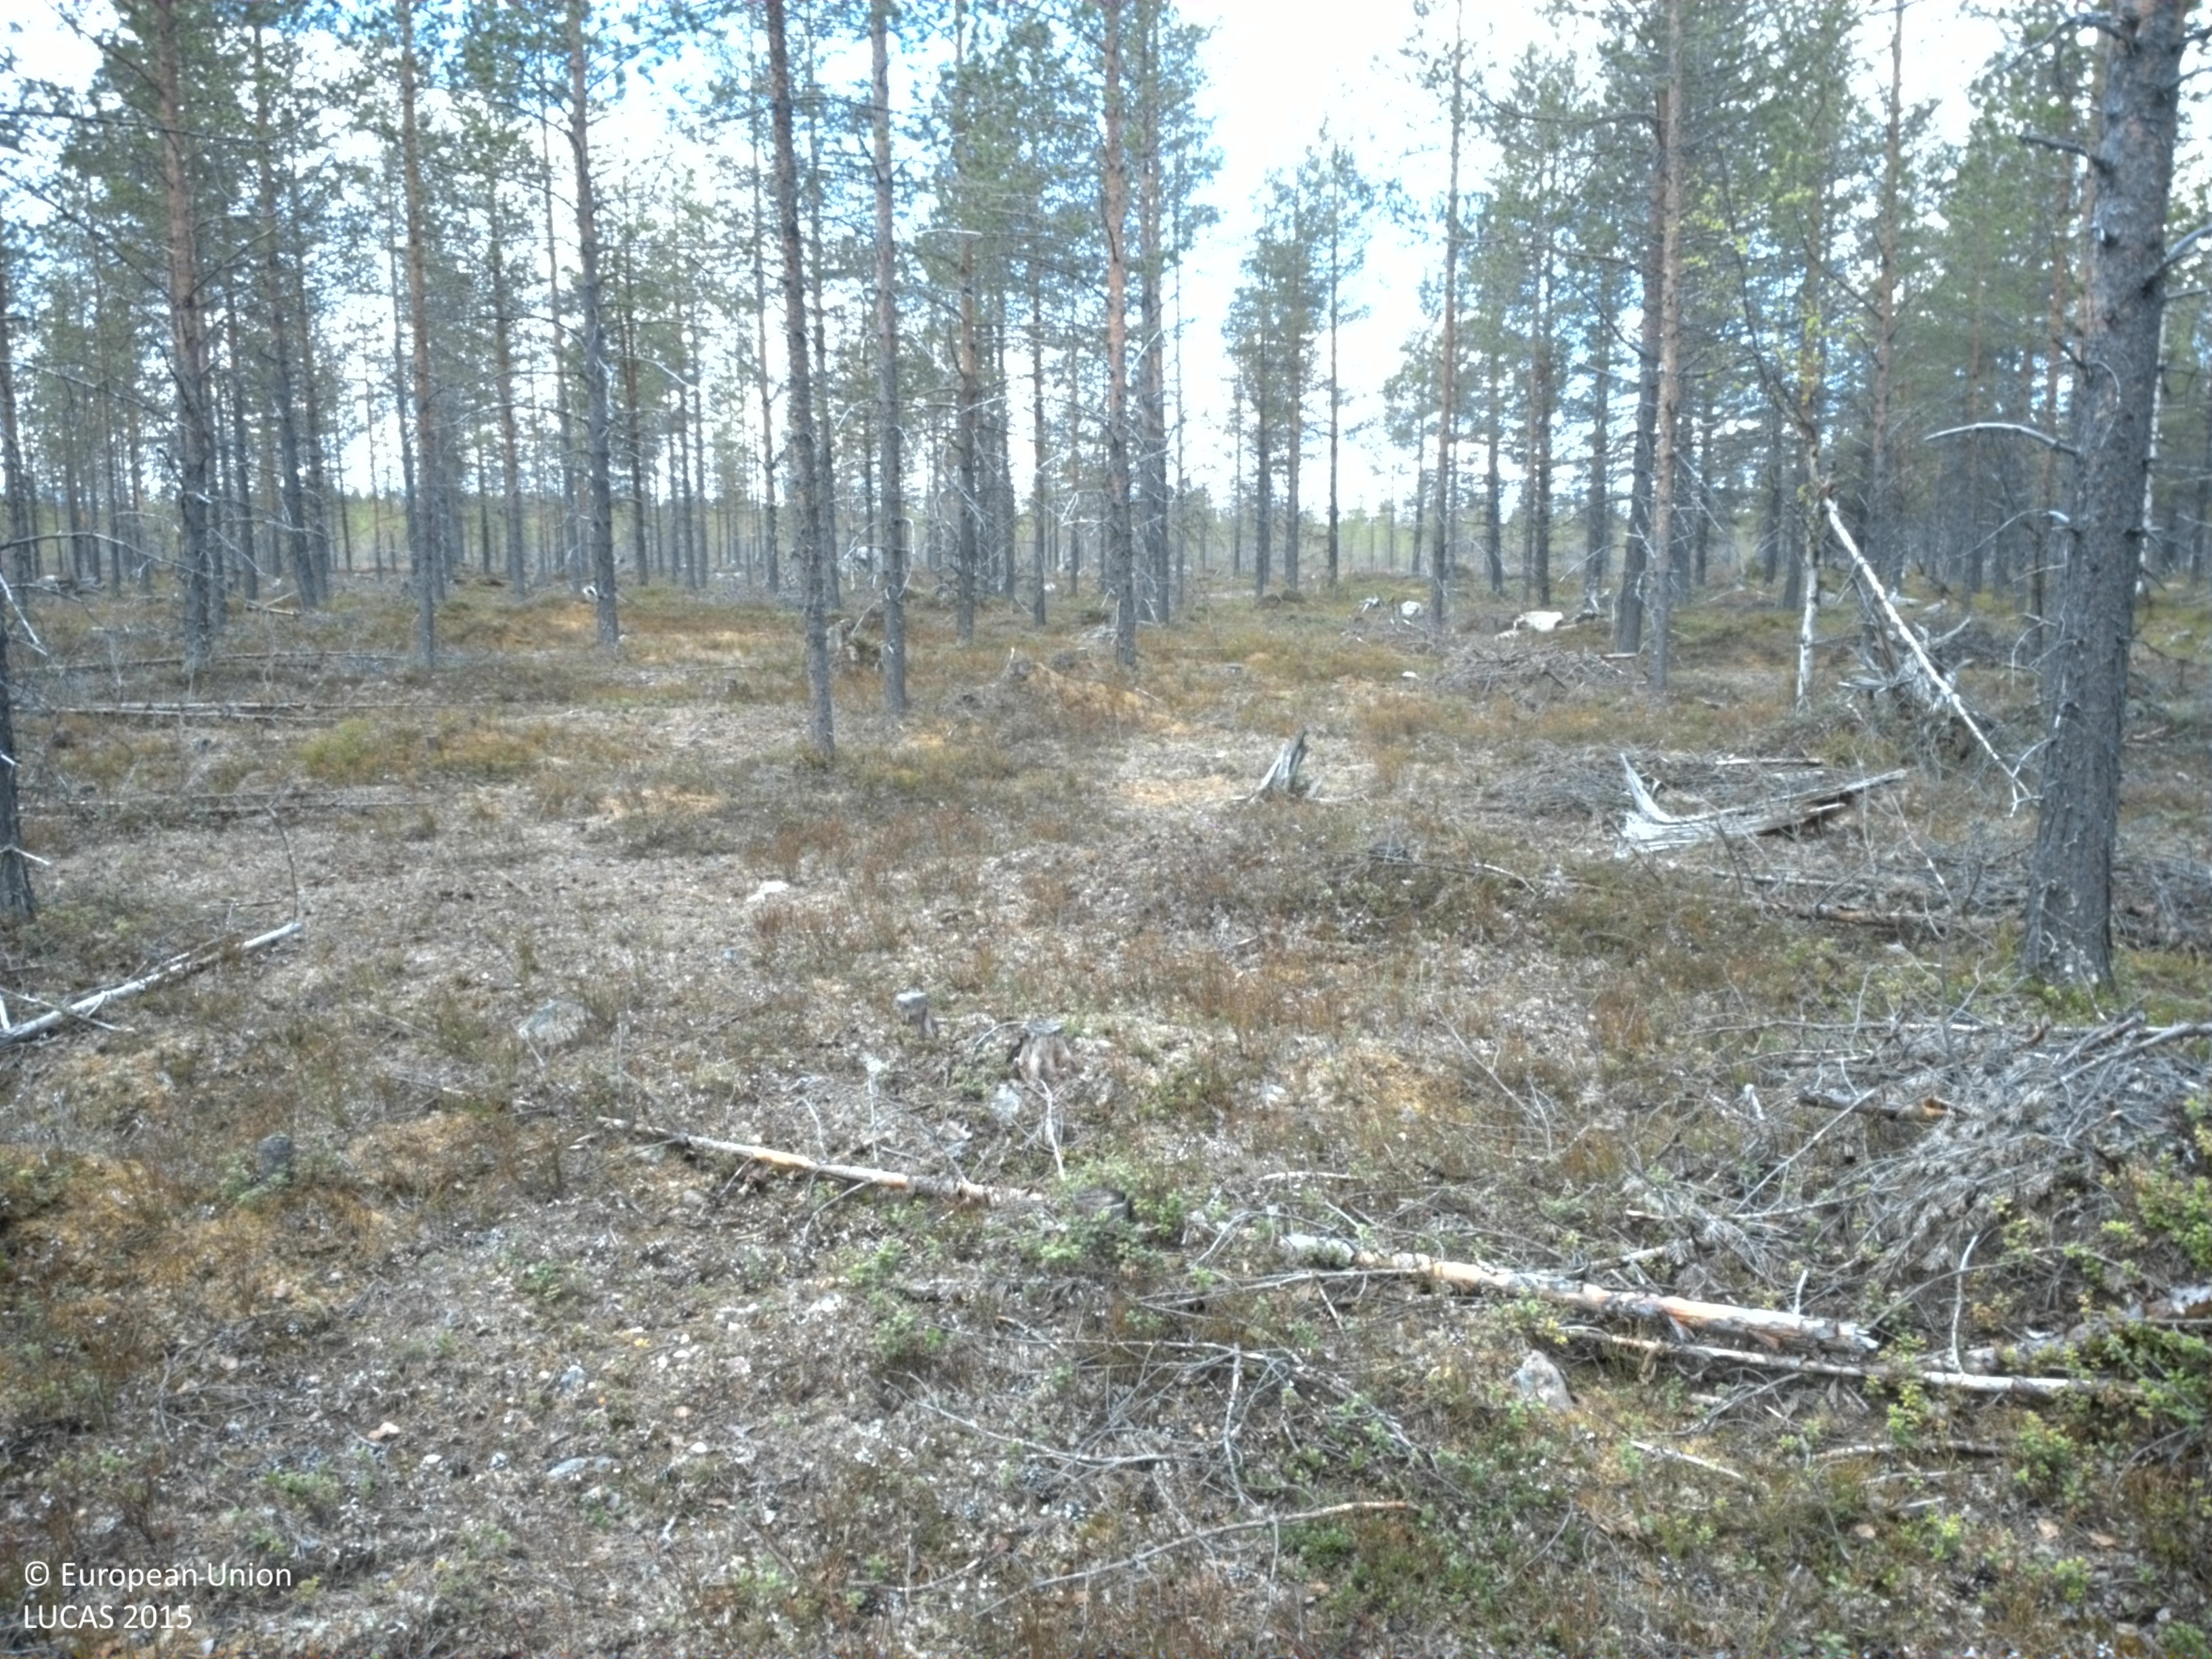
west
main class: Woodland
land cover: Pine dominated coniferous woodland
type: boreal forest
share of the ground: 25 - 50 %
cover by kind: shrubs 55 %, coniferous forest trees 40 %, lichens and mosses 5 %
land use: Forestry
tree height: > 5 m
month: June
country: SE
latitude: 66.2391
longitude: 18.6056
